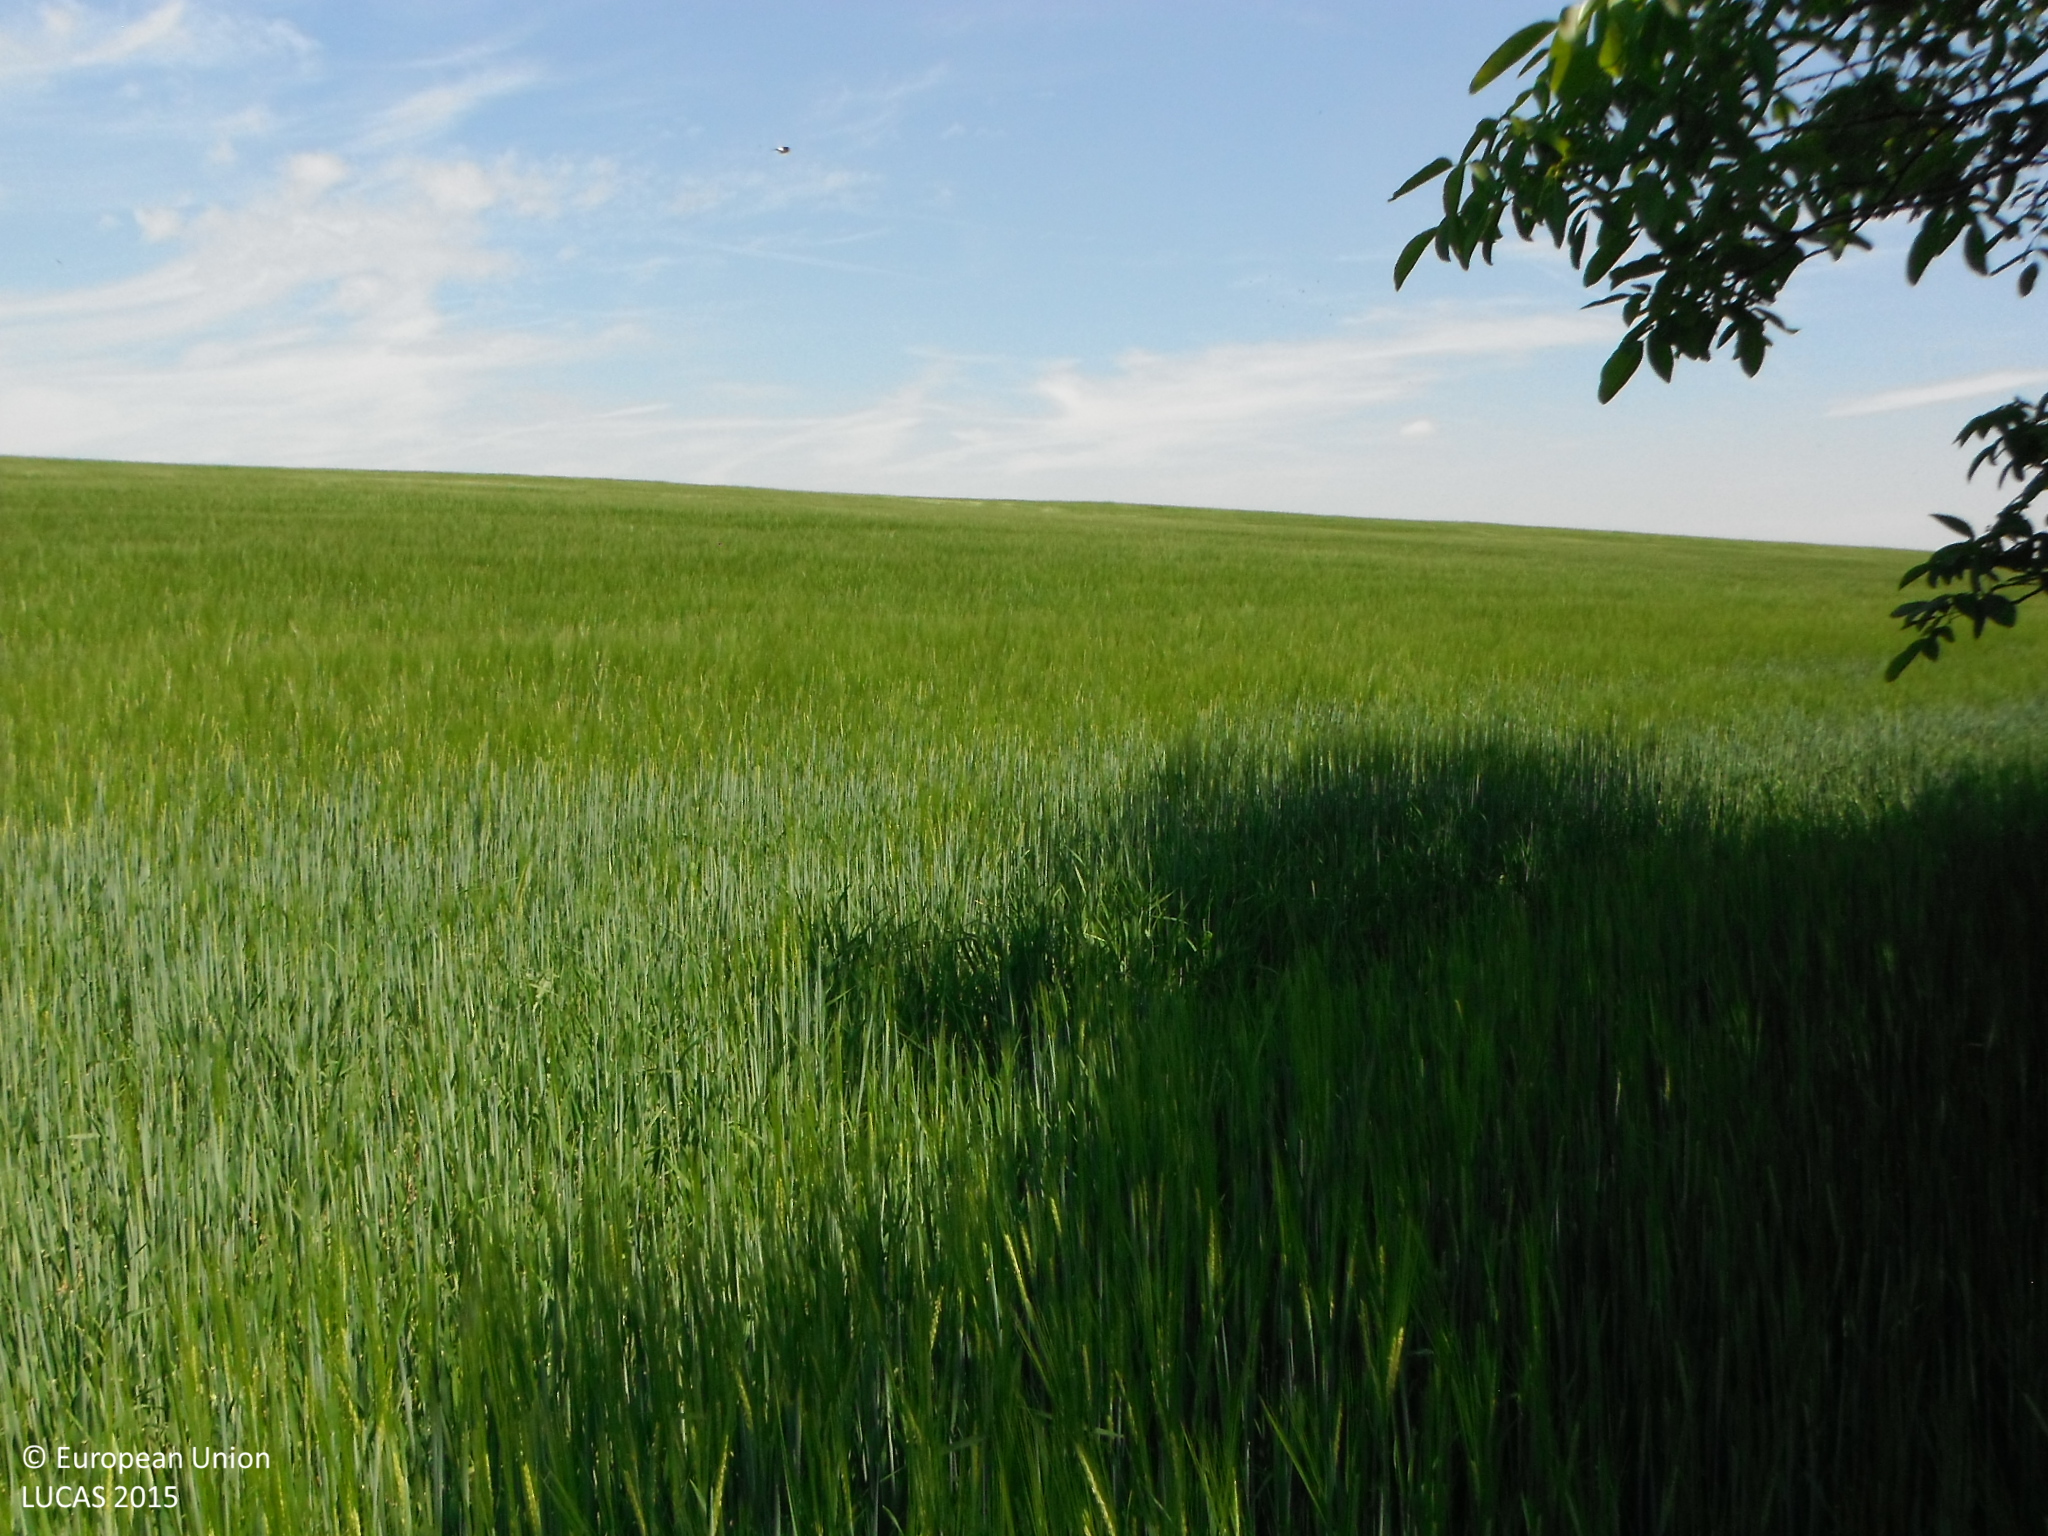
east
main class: Cropland
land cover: Barley
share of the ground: > 75 %
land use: Agriculture (excluding fallow land and kitchen gardens)
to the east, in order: Barley
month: June
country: SK
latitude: 48.3529
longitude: 17.4185
